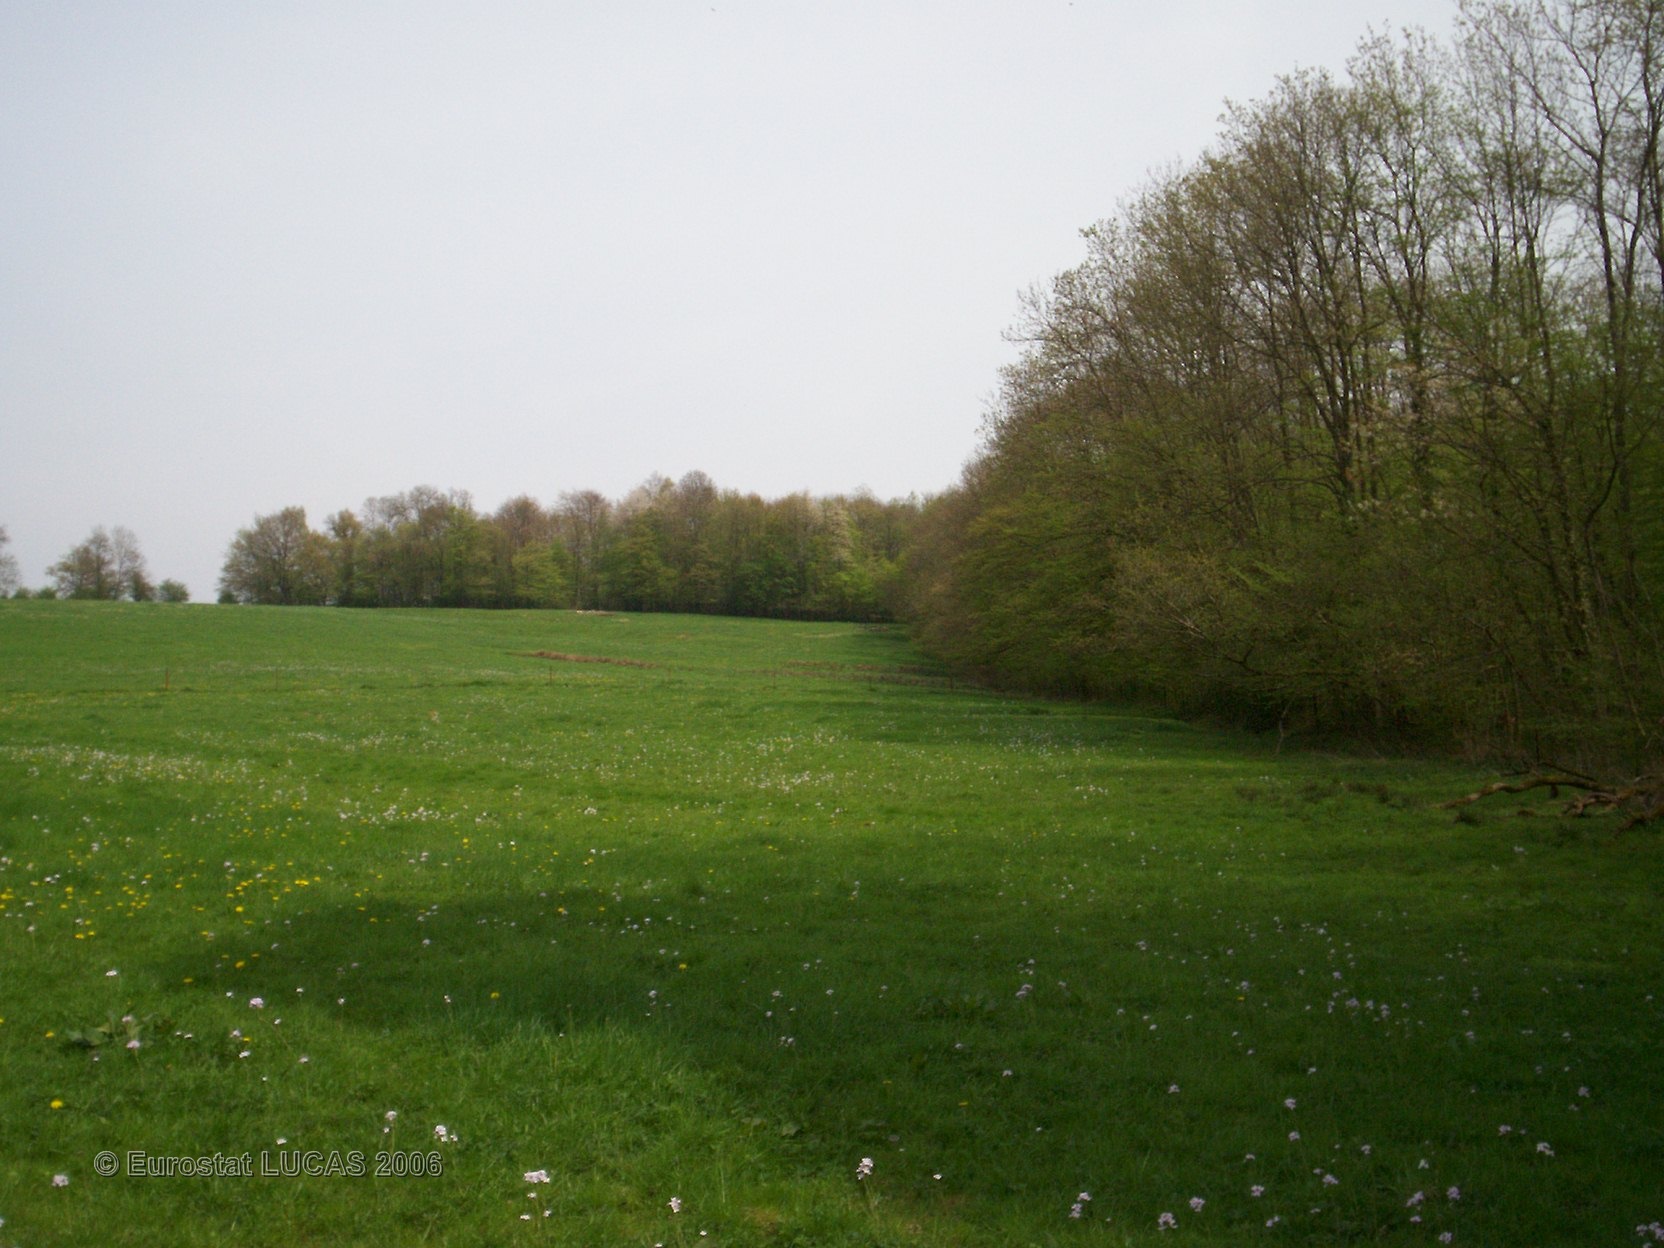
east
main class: Grassland
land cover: Grassland without tree/shrub cover
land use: Agriculture (excluding fallow land and kitchen gardens)
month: May
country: FR
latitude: 49.8824
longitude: 4.3592
